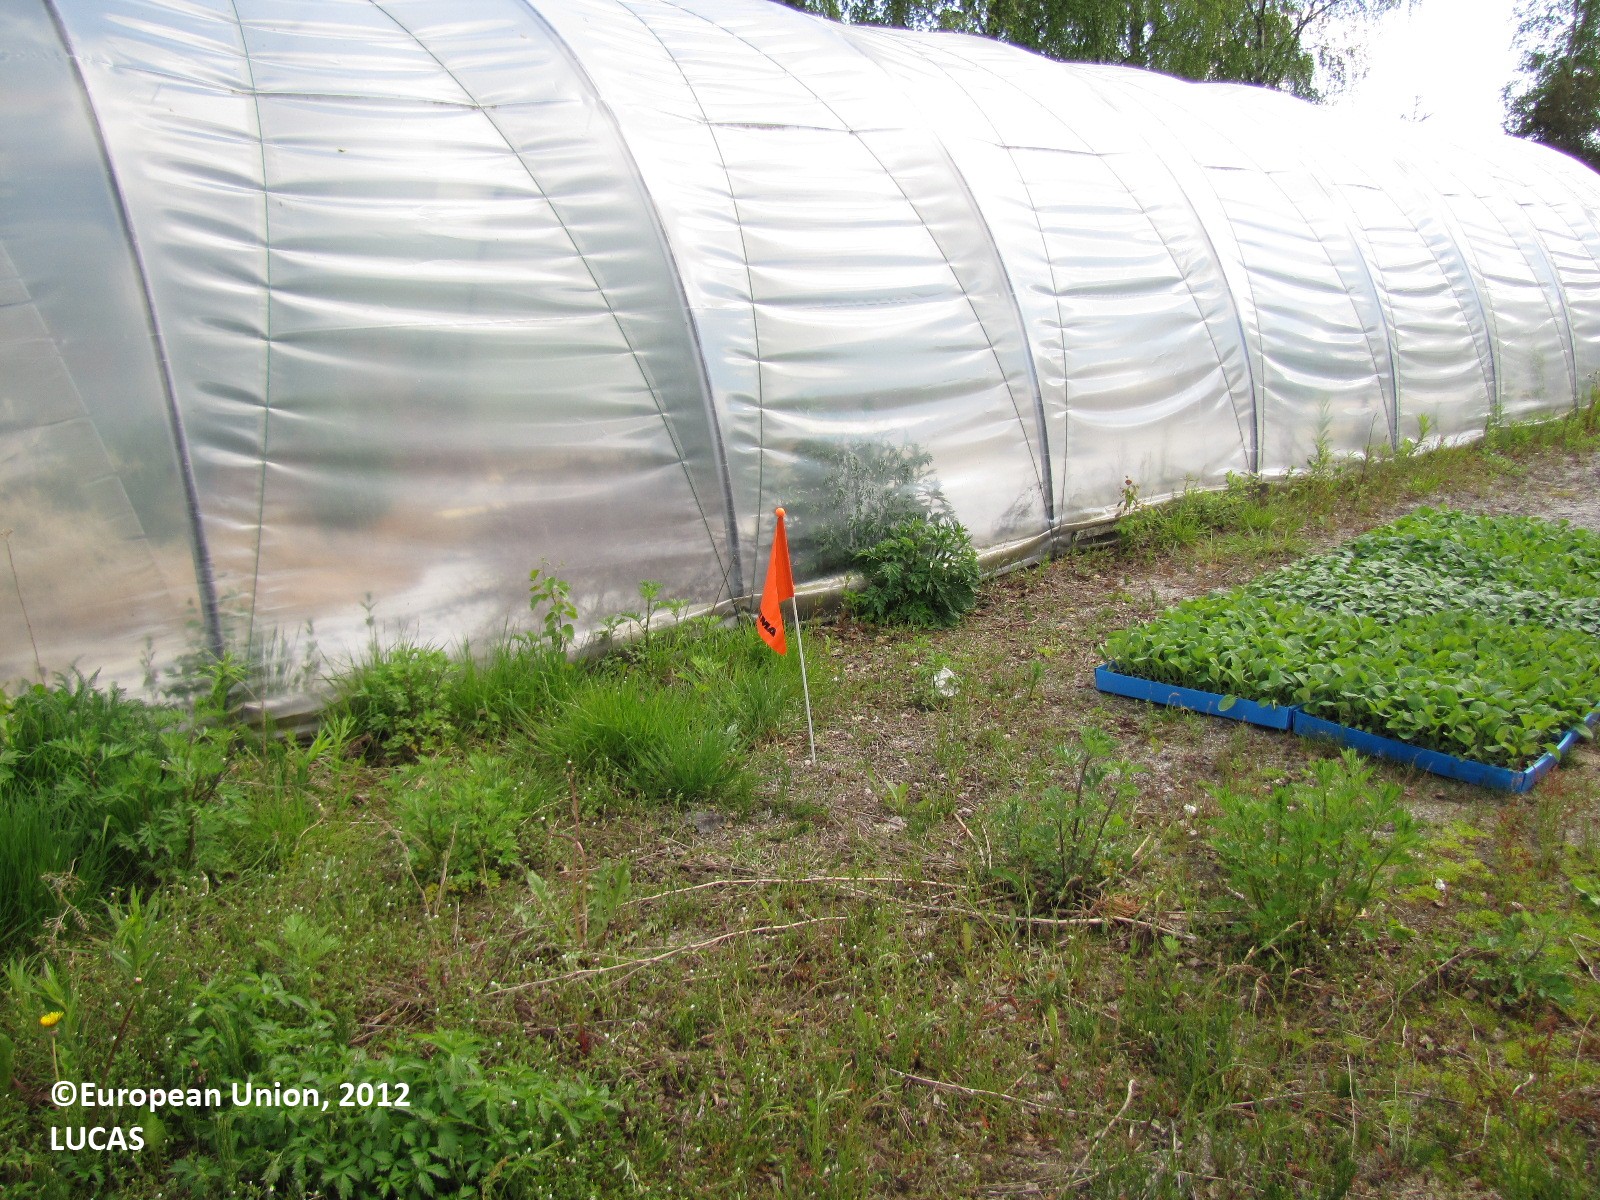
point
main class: Artificial land
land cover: Greenhouses
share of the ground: 25 - 50 %
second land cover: Floriculture and ornamental plants
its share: 25 - 50 %
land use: Agriculture (excluding fallow land and kitchen gardens)
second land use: Fallow land
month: June
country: FI
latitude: 61.2834
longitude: 22.9263
